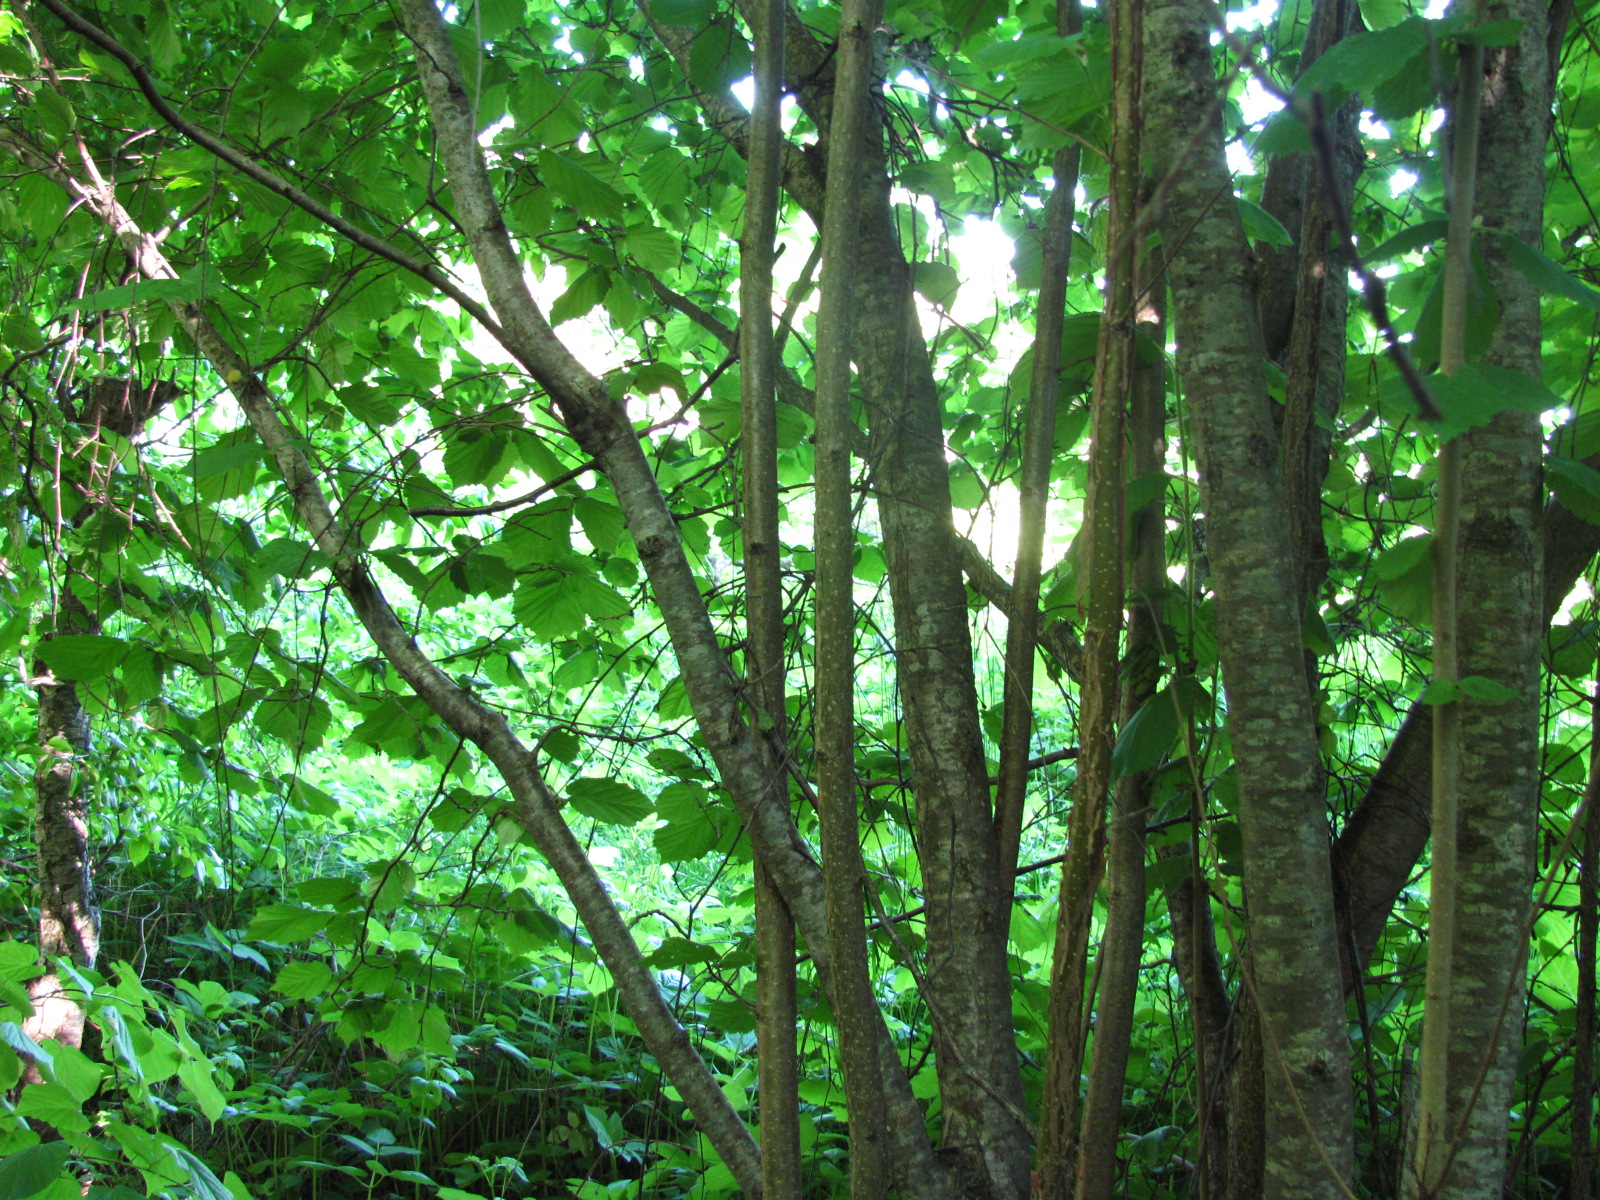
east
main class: Woodland
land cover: Broadleaved woodland
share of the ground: > 75 %
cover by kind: broadleaved forest trees 100 %
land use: Residential
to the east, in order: Broadleaved woodland; Spontaneously vegetated surfaces; Other fresh vegetables; Artificial constructions in urban areas; Broadleaved woodland; Dry pulses; Grass margins; Fences; Grassland with sparse tree/shrub cover; Spontaneously vegetated surfaces; Grassland without tree/shrub cover; Lines of trees; Grassland without tree/shrub cover
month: June
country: LV
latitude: 56.4475
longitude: 24.2533
